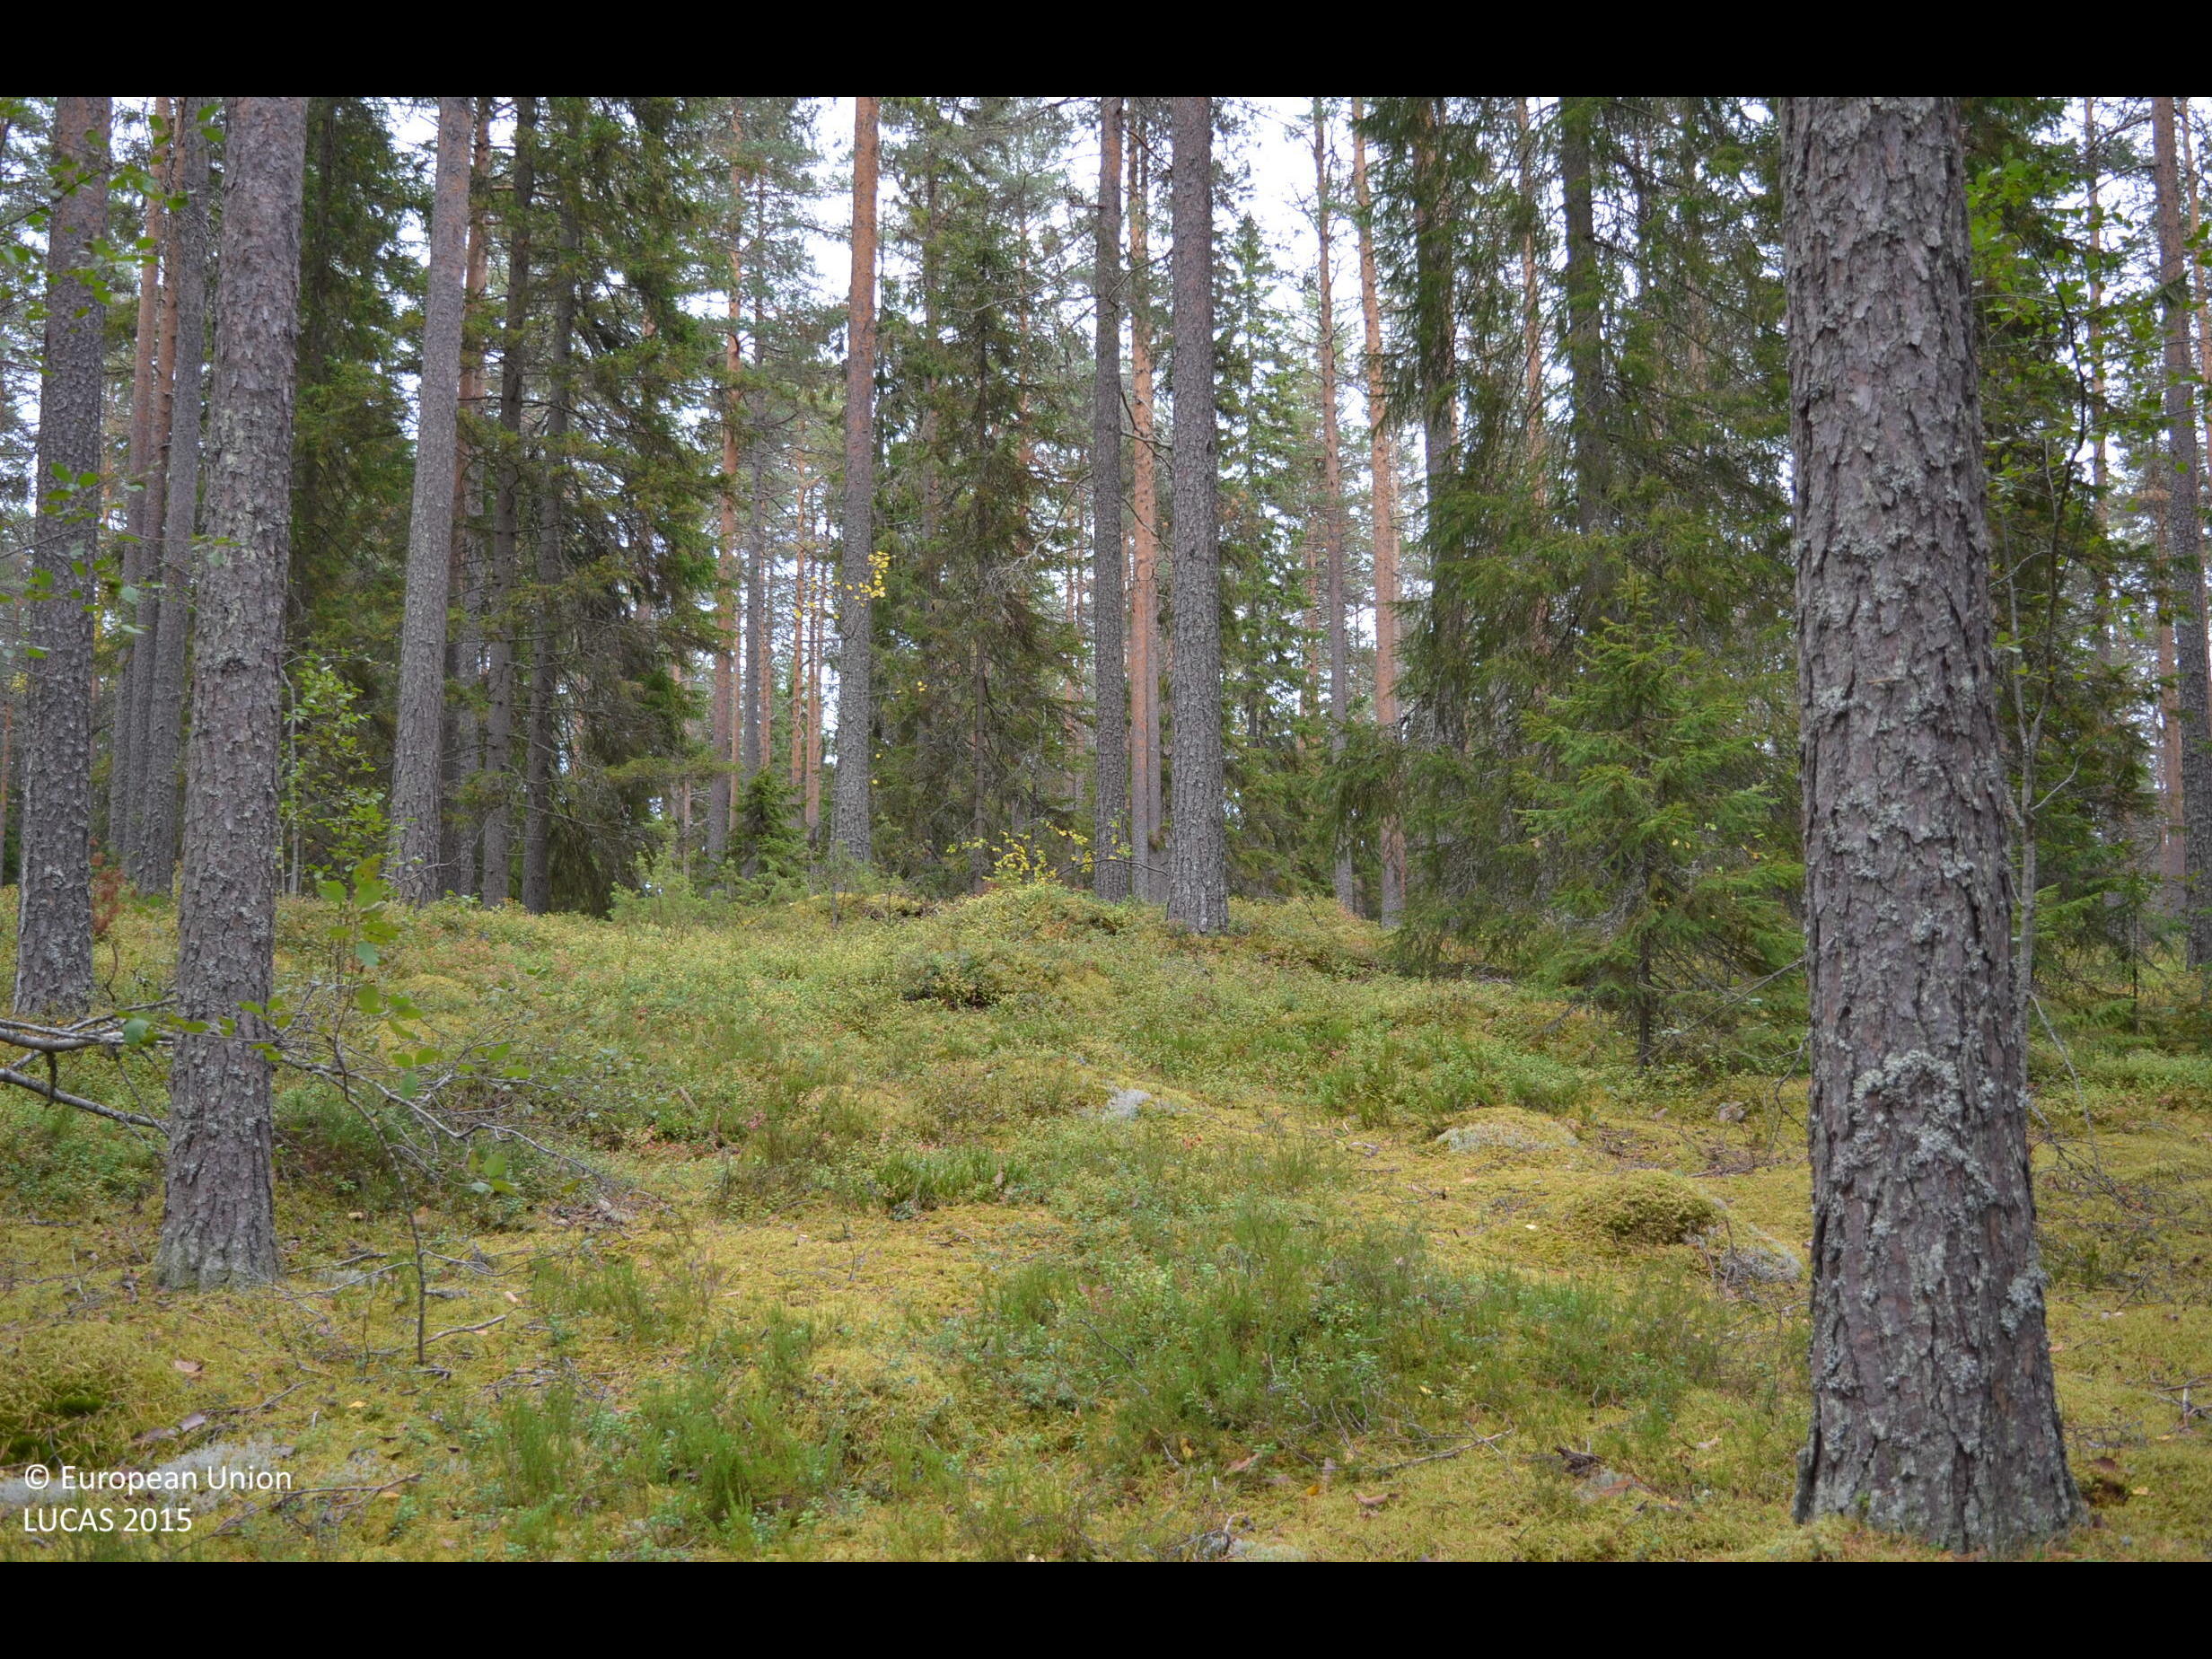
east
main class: Woodland
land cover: Other coniferous woodland
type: boreal forest
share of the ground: 50 - 75 %
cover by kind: coniferous forest trees 70 %, shrubs 15 %, lichens and mosses 15 %
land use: Forestry
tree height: > 5 m
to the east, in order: Other coniferous woodland; Rivers and streams; Other mixed woodland; Broadleaved woodland; Pine dominated mixed woodland
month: September
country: FI
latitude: 62.8537
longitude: 23.8054
